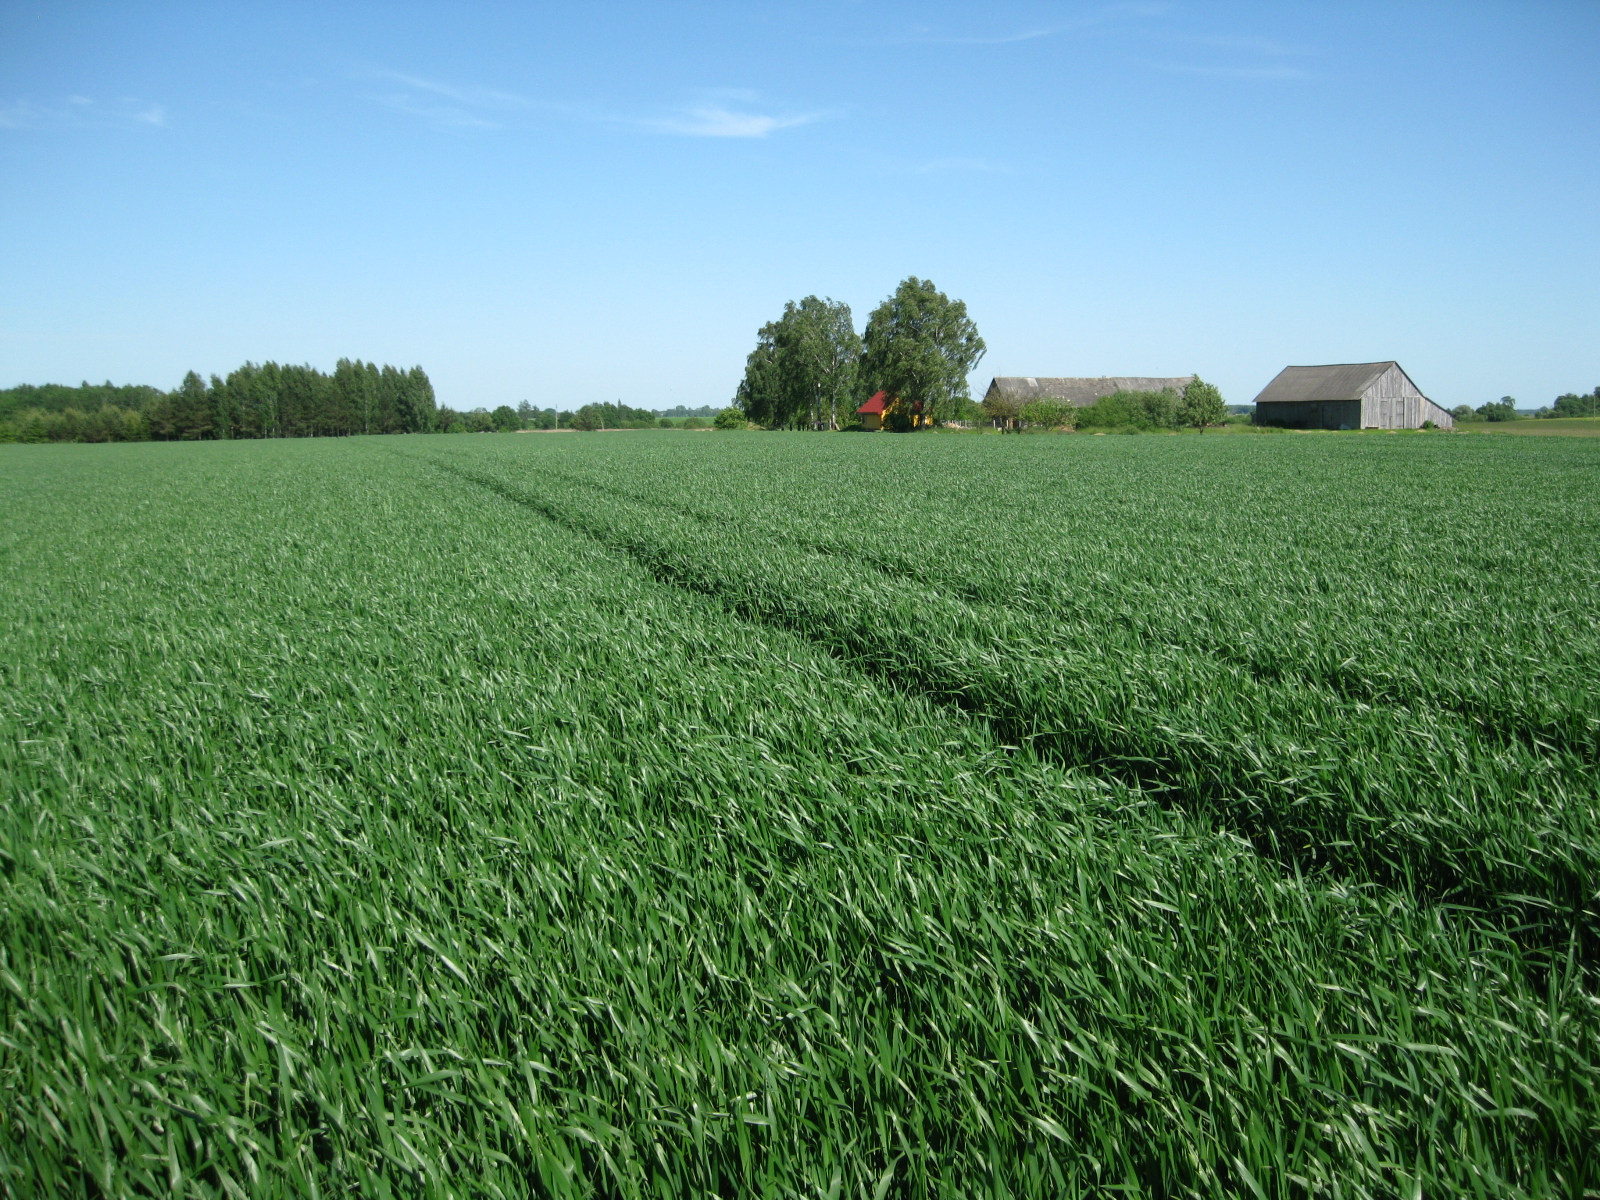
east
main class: Cropland
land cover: Common wheat
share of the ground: > 75 %
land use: Agriculture (excluding fallow land and kitchen gardens)
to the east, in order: Common wheat; Grassland without tree/shrub cover
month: June
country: LT
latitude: 55.8674
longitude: 23.8760
